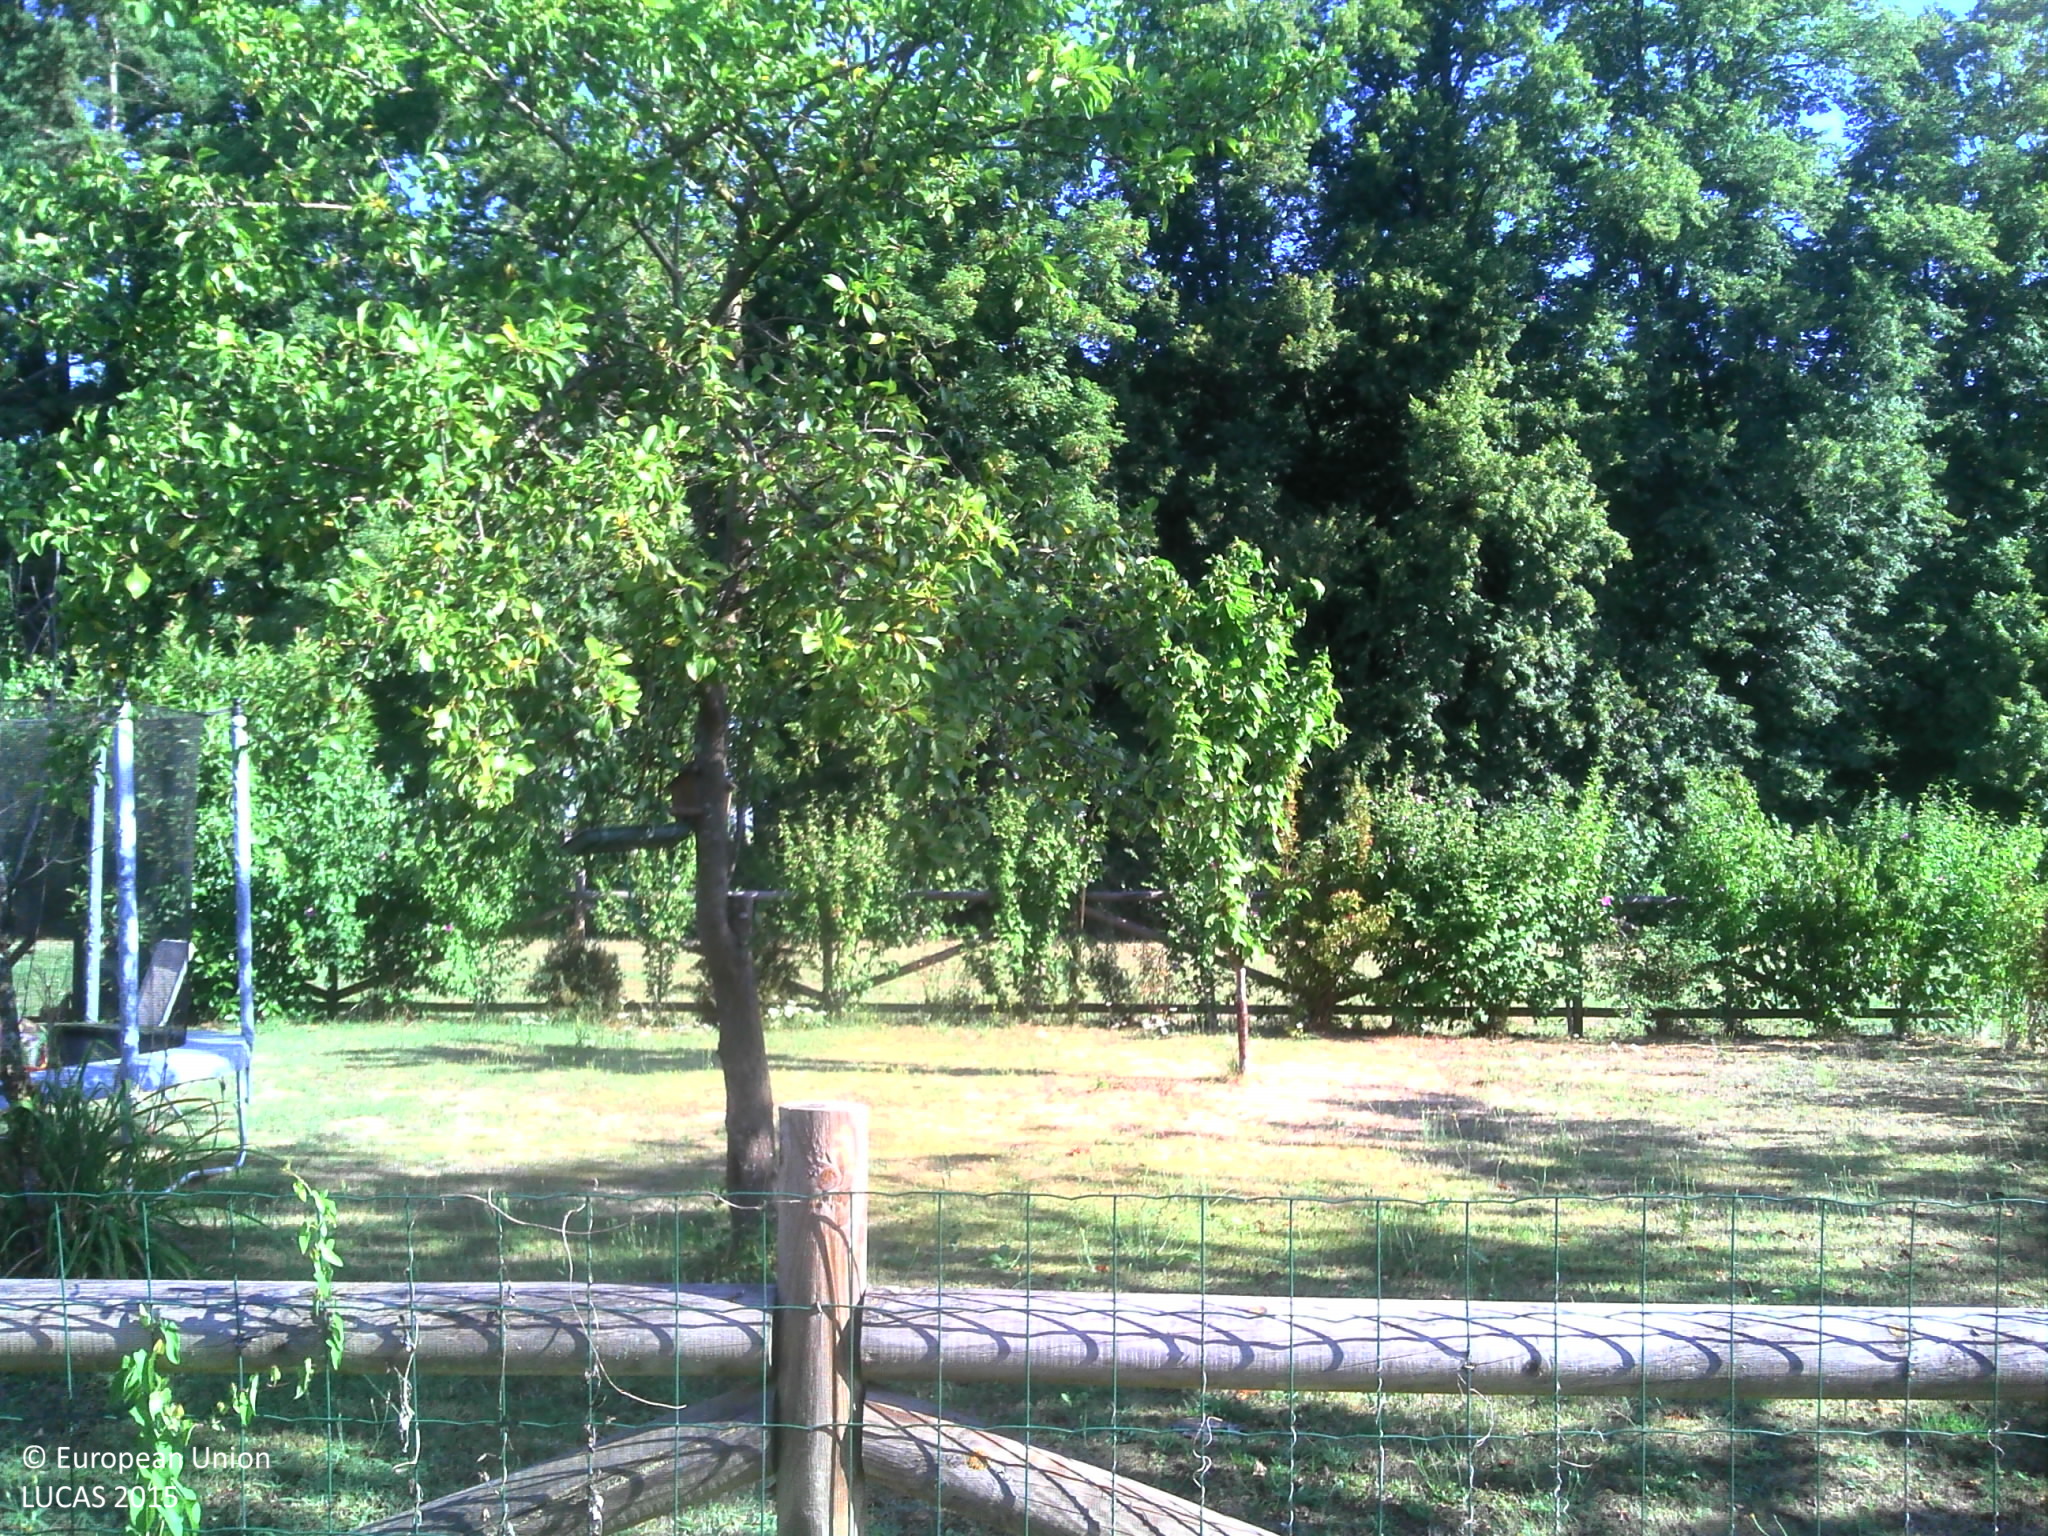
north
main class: Grassland
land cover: Grassland with sparse tree/shrub cover
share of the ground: > 75 %
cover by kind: herbaceous plants 95 %, broadleaved forest trees 5 %
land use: Residential
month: July
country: FR
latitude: 46.7328
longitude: 4.8585
